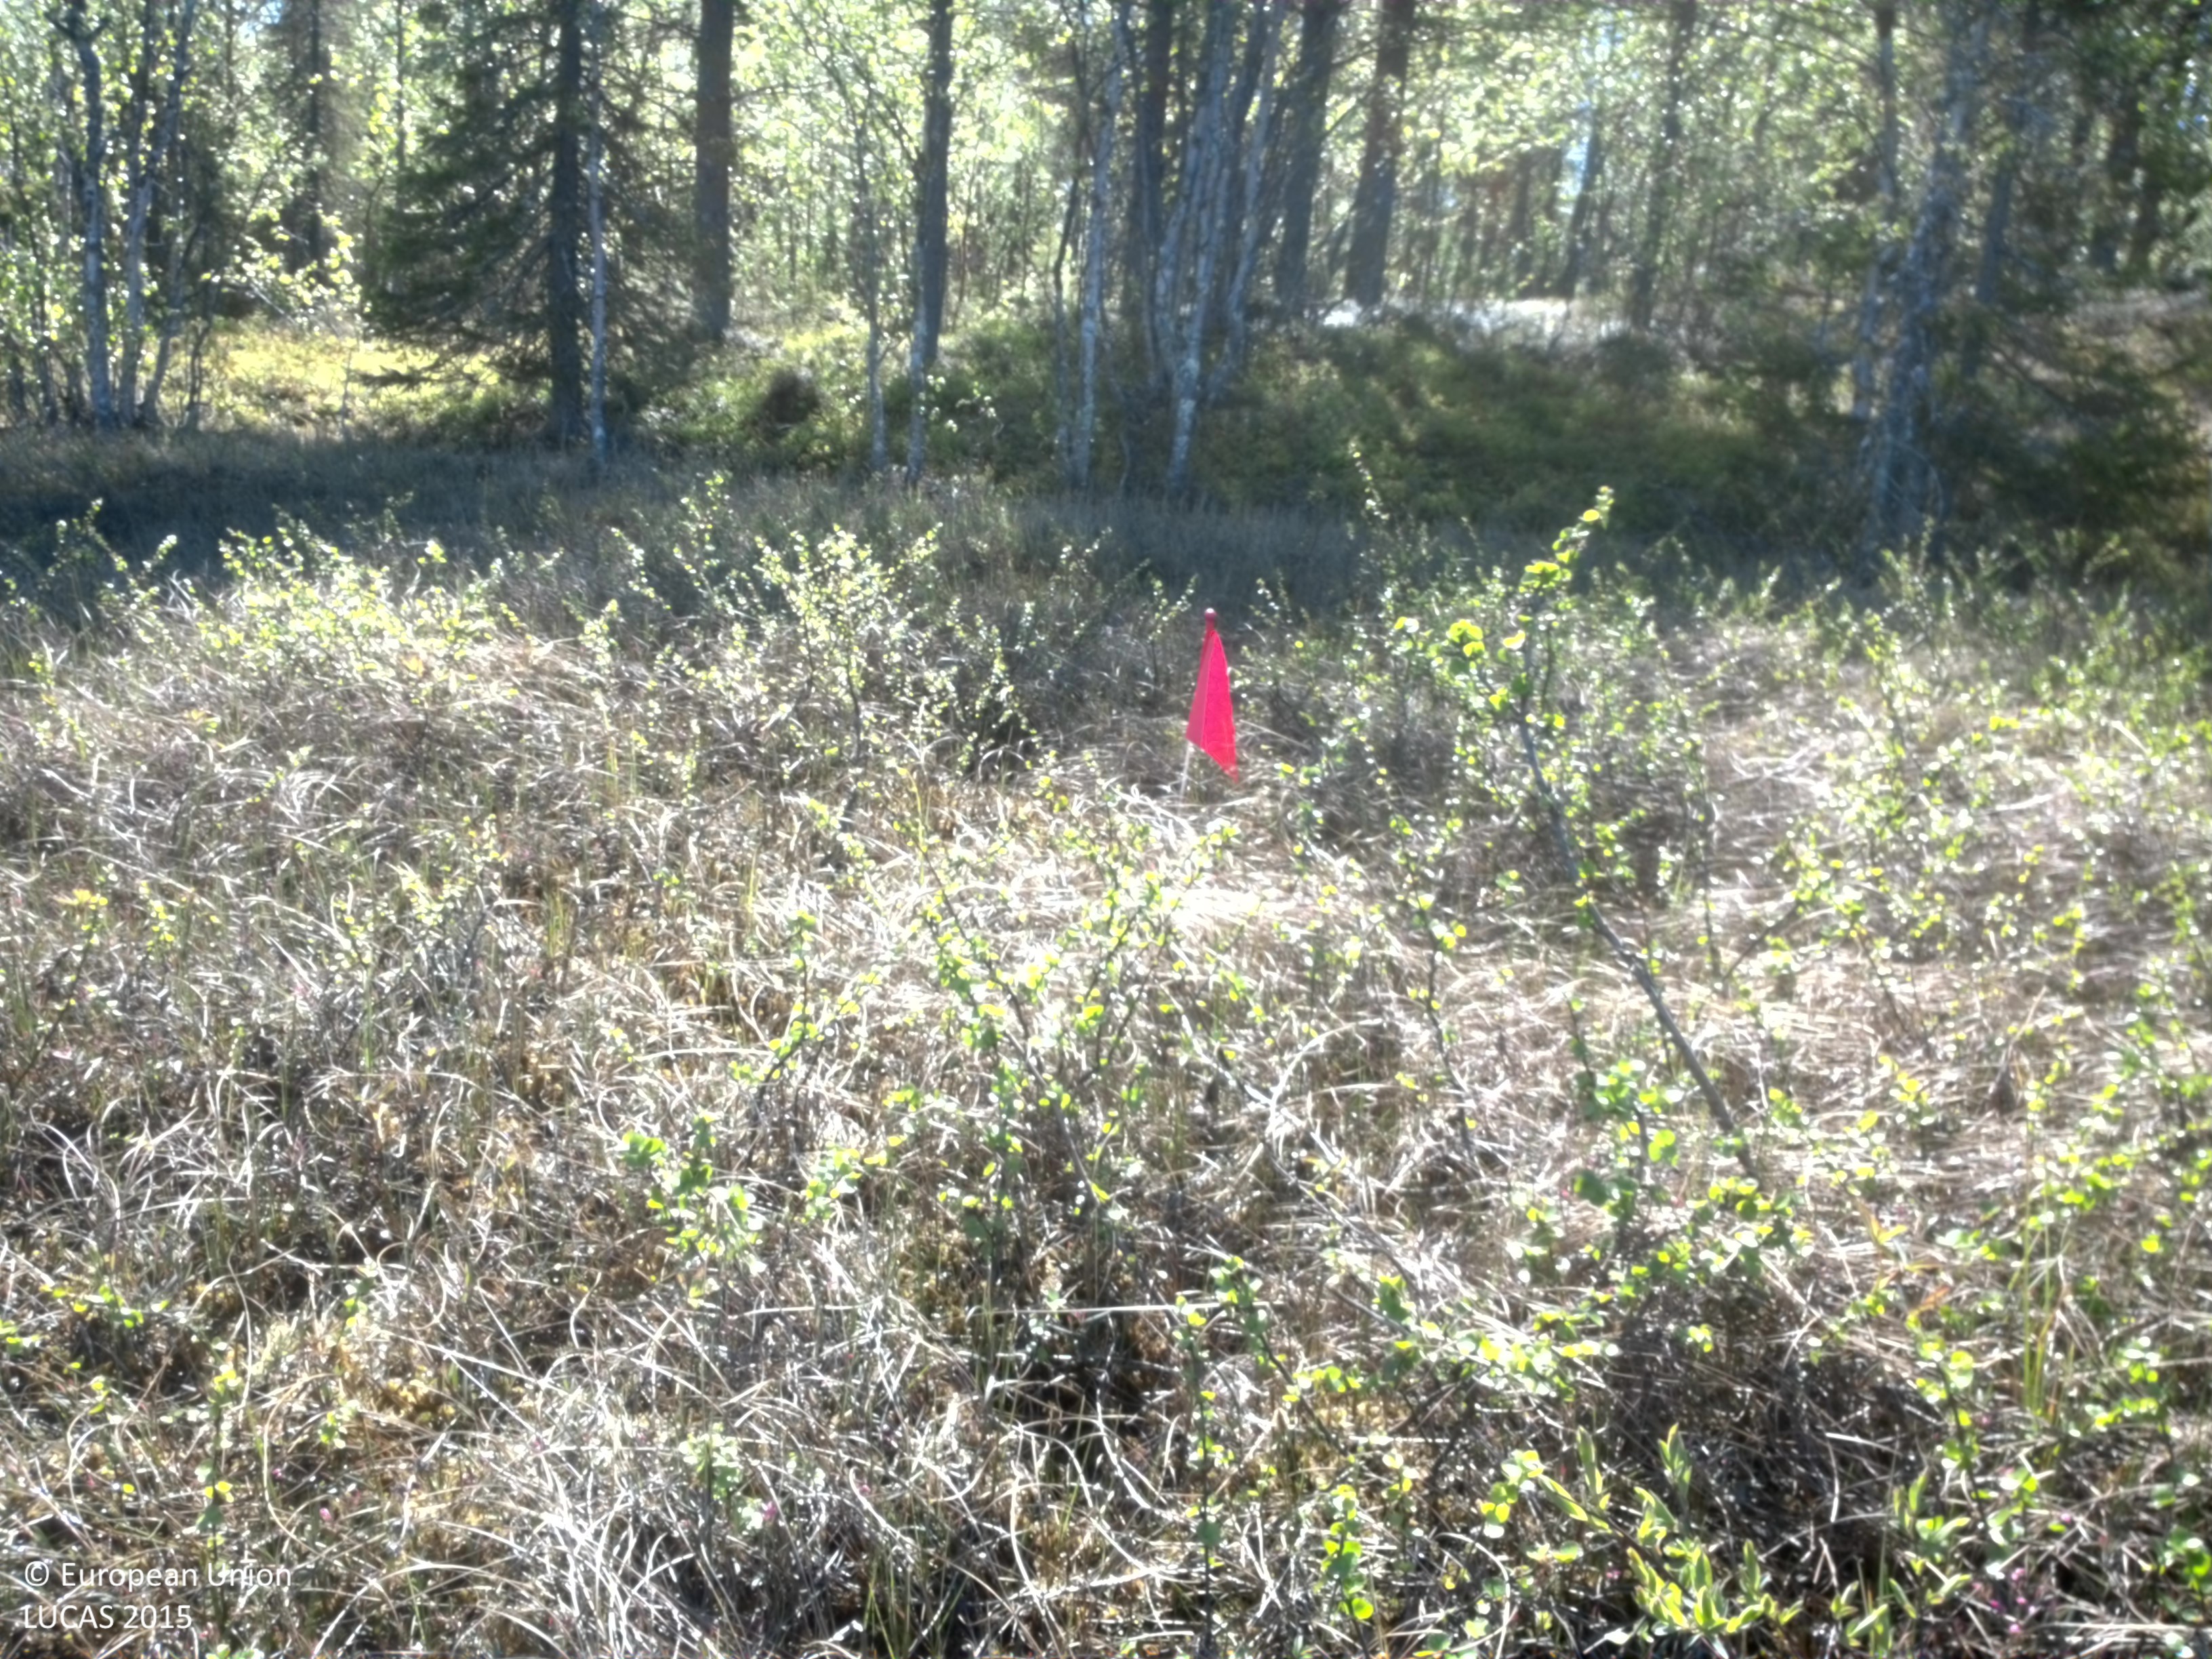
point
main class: Shrubland
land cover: Shrubland with sparse tree cover
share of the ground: 50 - 75 %
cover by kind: shrubs 50 %, herbaceous plants 45 %, broadleaved forest trees 5 %
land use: Semi-natural and natural areas not in use
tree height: < 5 m
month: June
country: SE
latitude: 67.1823
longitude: 21.2519
